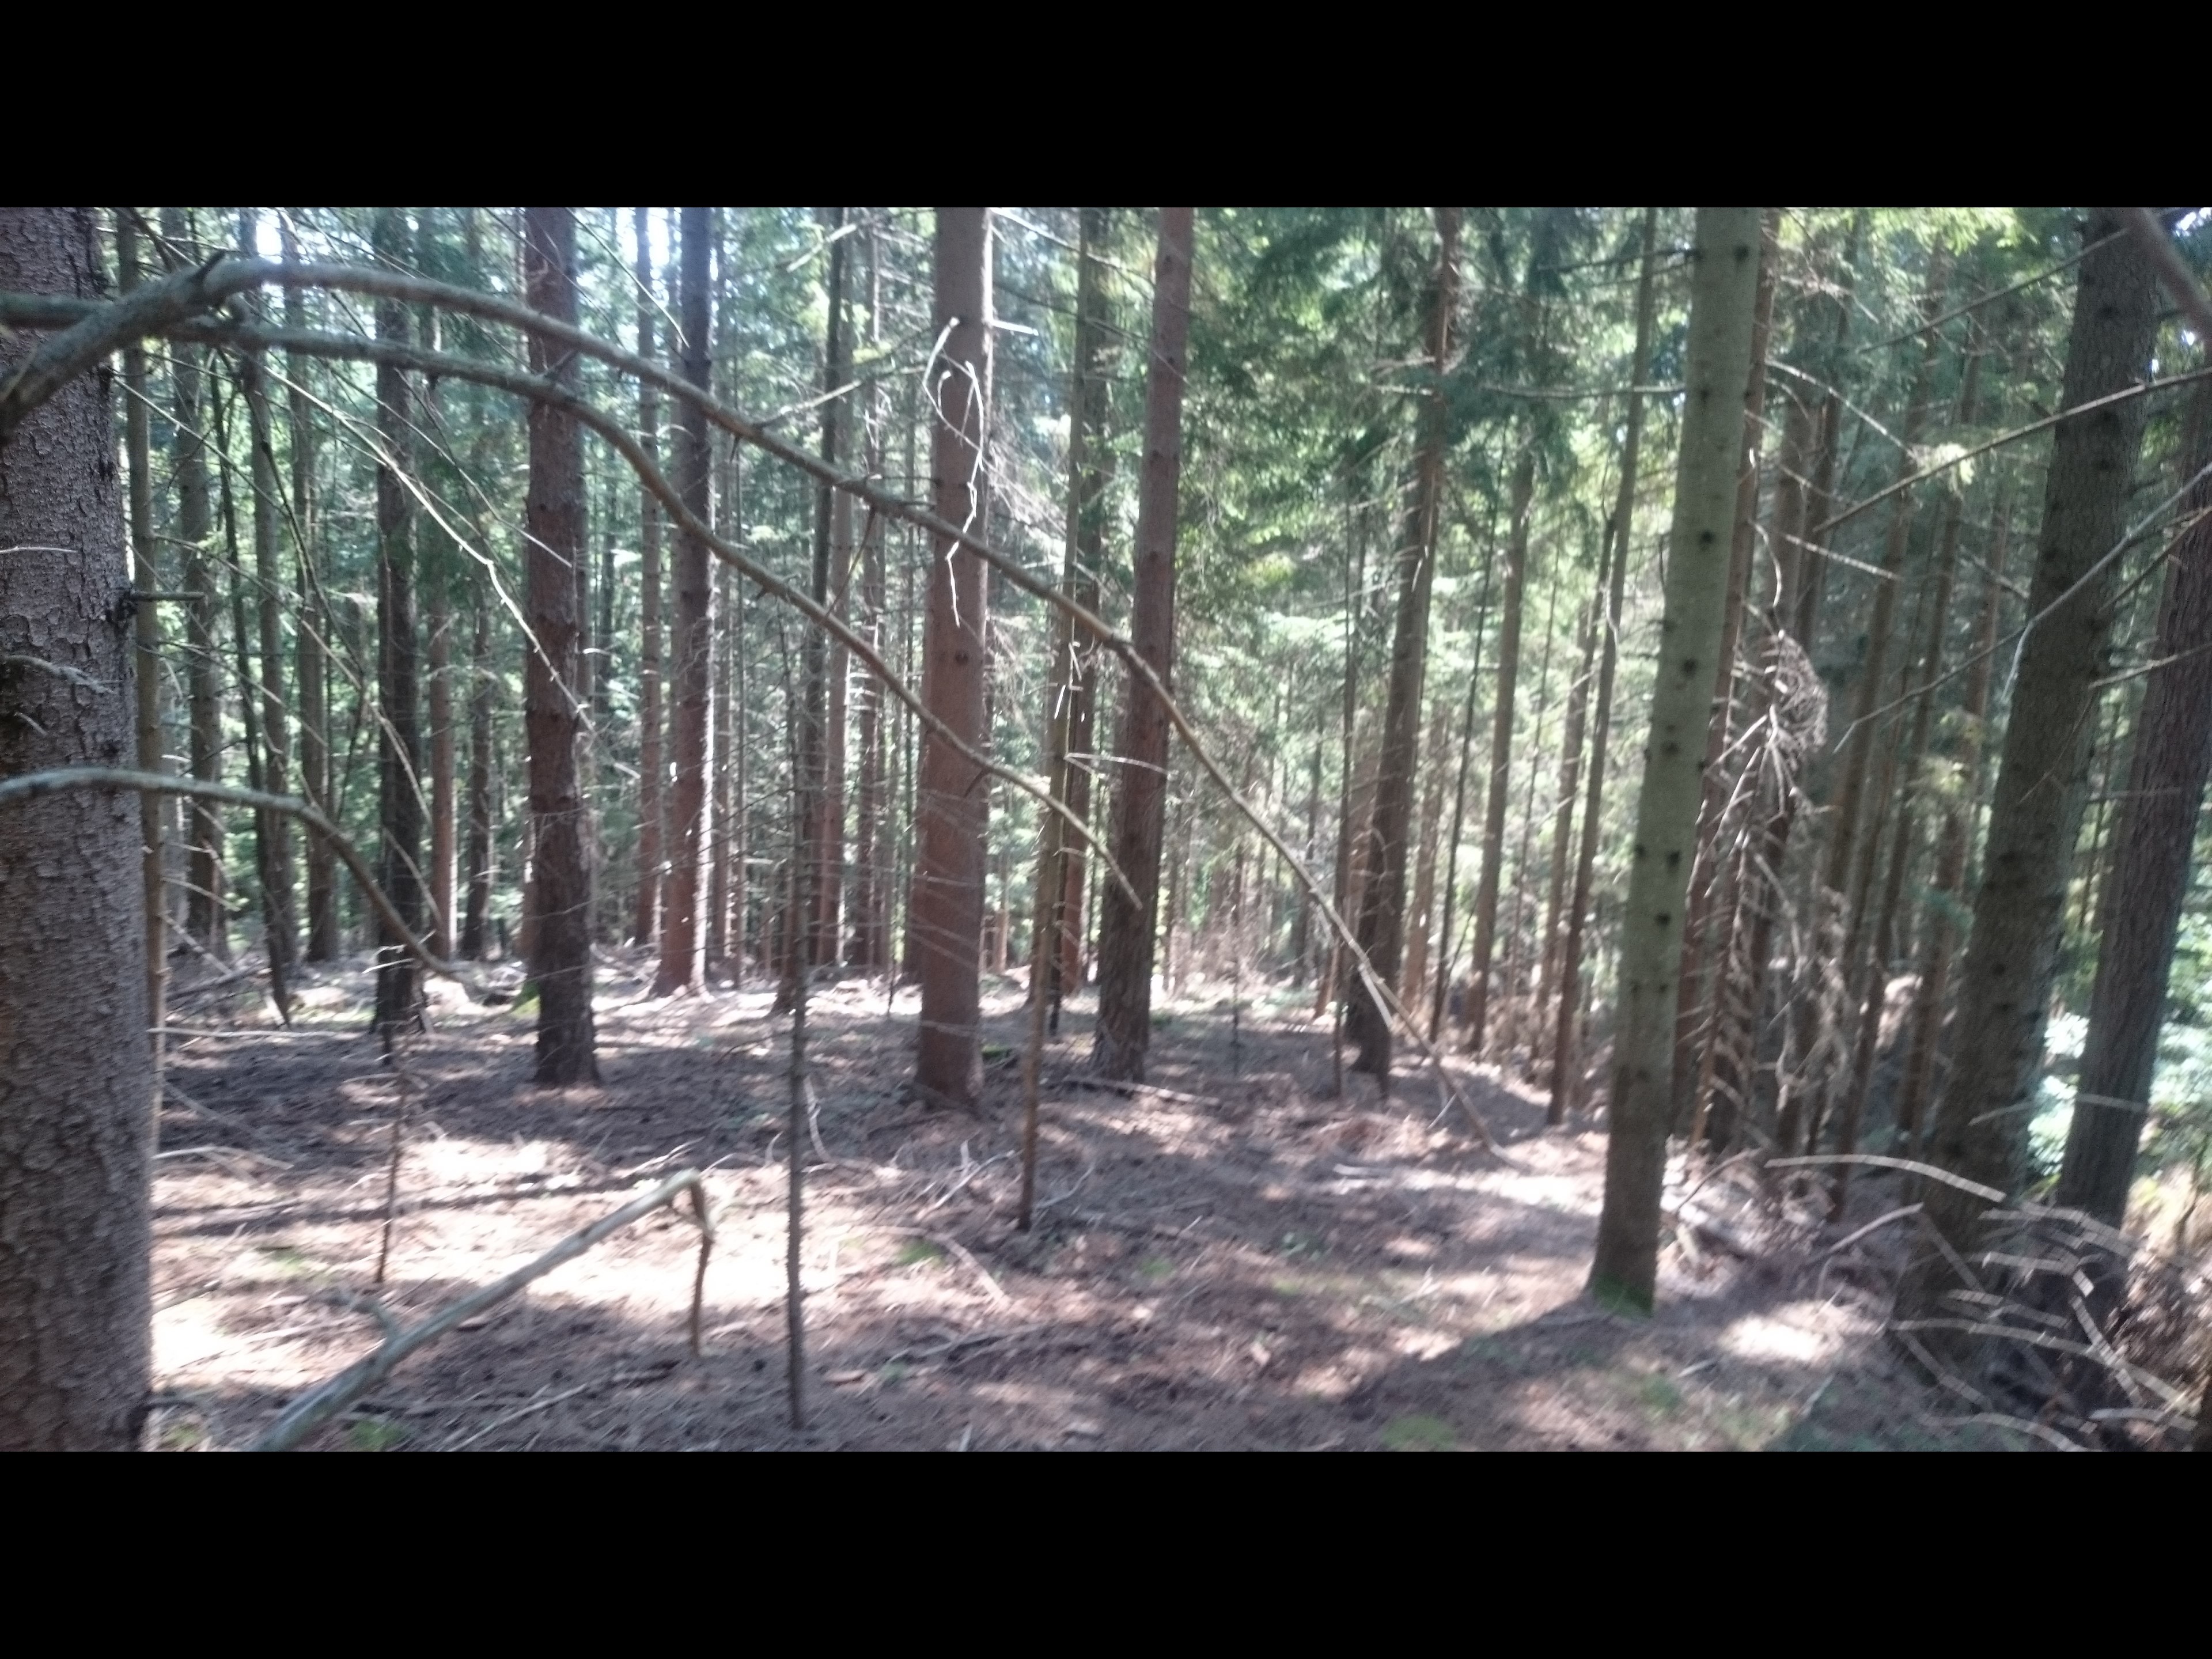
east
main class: Woodland
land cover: Spruce dominated coniferous woodland
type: hemiboreal forest and nemoral coniferous forest and mixed broadleaved-coniferous forest
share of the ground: > 75 %
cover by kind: coniferous forest trees 90 %, consolidated bare surface 10 %
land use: Forestry
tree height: > 5 m
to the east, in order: Spruce dominated coniferous woodland; Tracks; Spruce dominated coniferous woodland; Tracks; Spruce dominated coniferous woodland; Grassland without tree/shrub cover; Broadleaved woodland; Grass margins; Paved roads, cycling and walking lanes; Grass margins; Fences; Grassland without tree/shrub cover
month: July
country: AT
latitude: 47.2021
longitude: 15.5051
